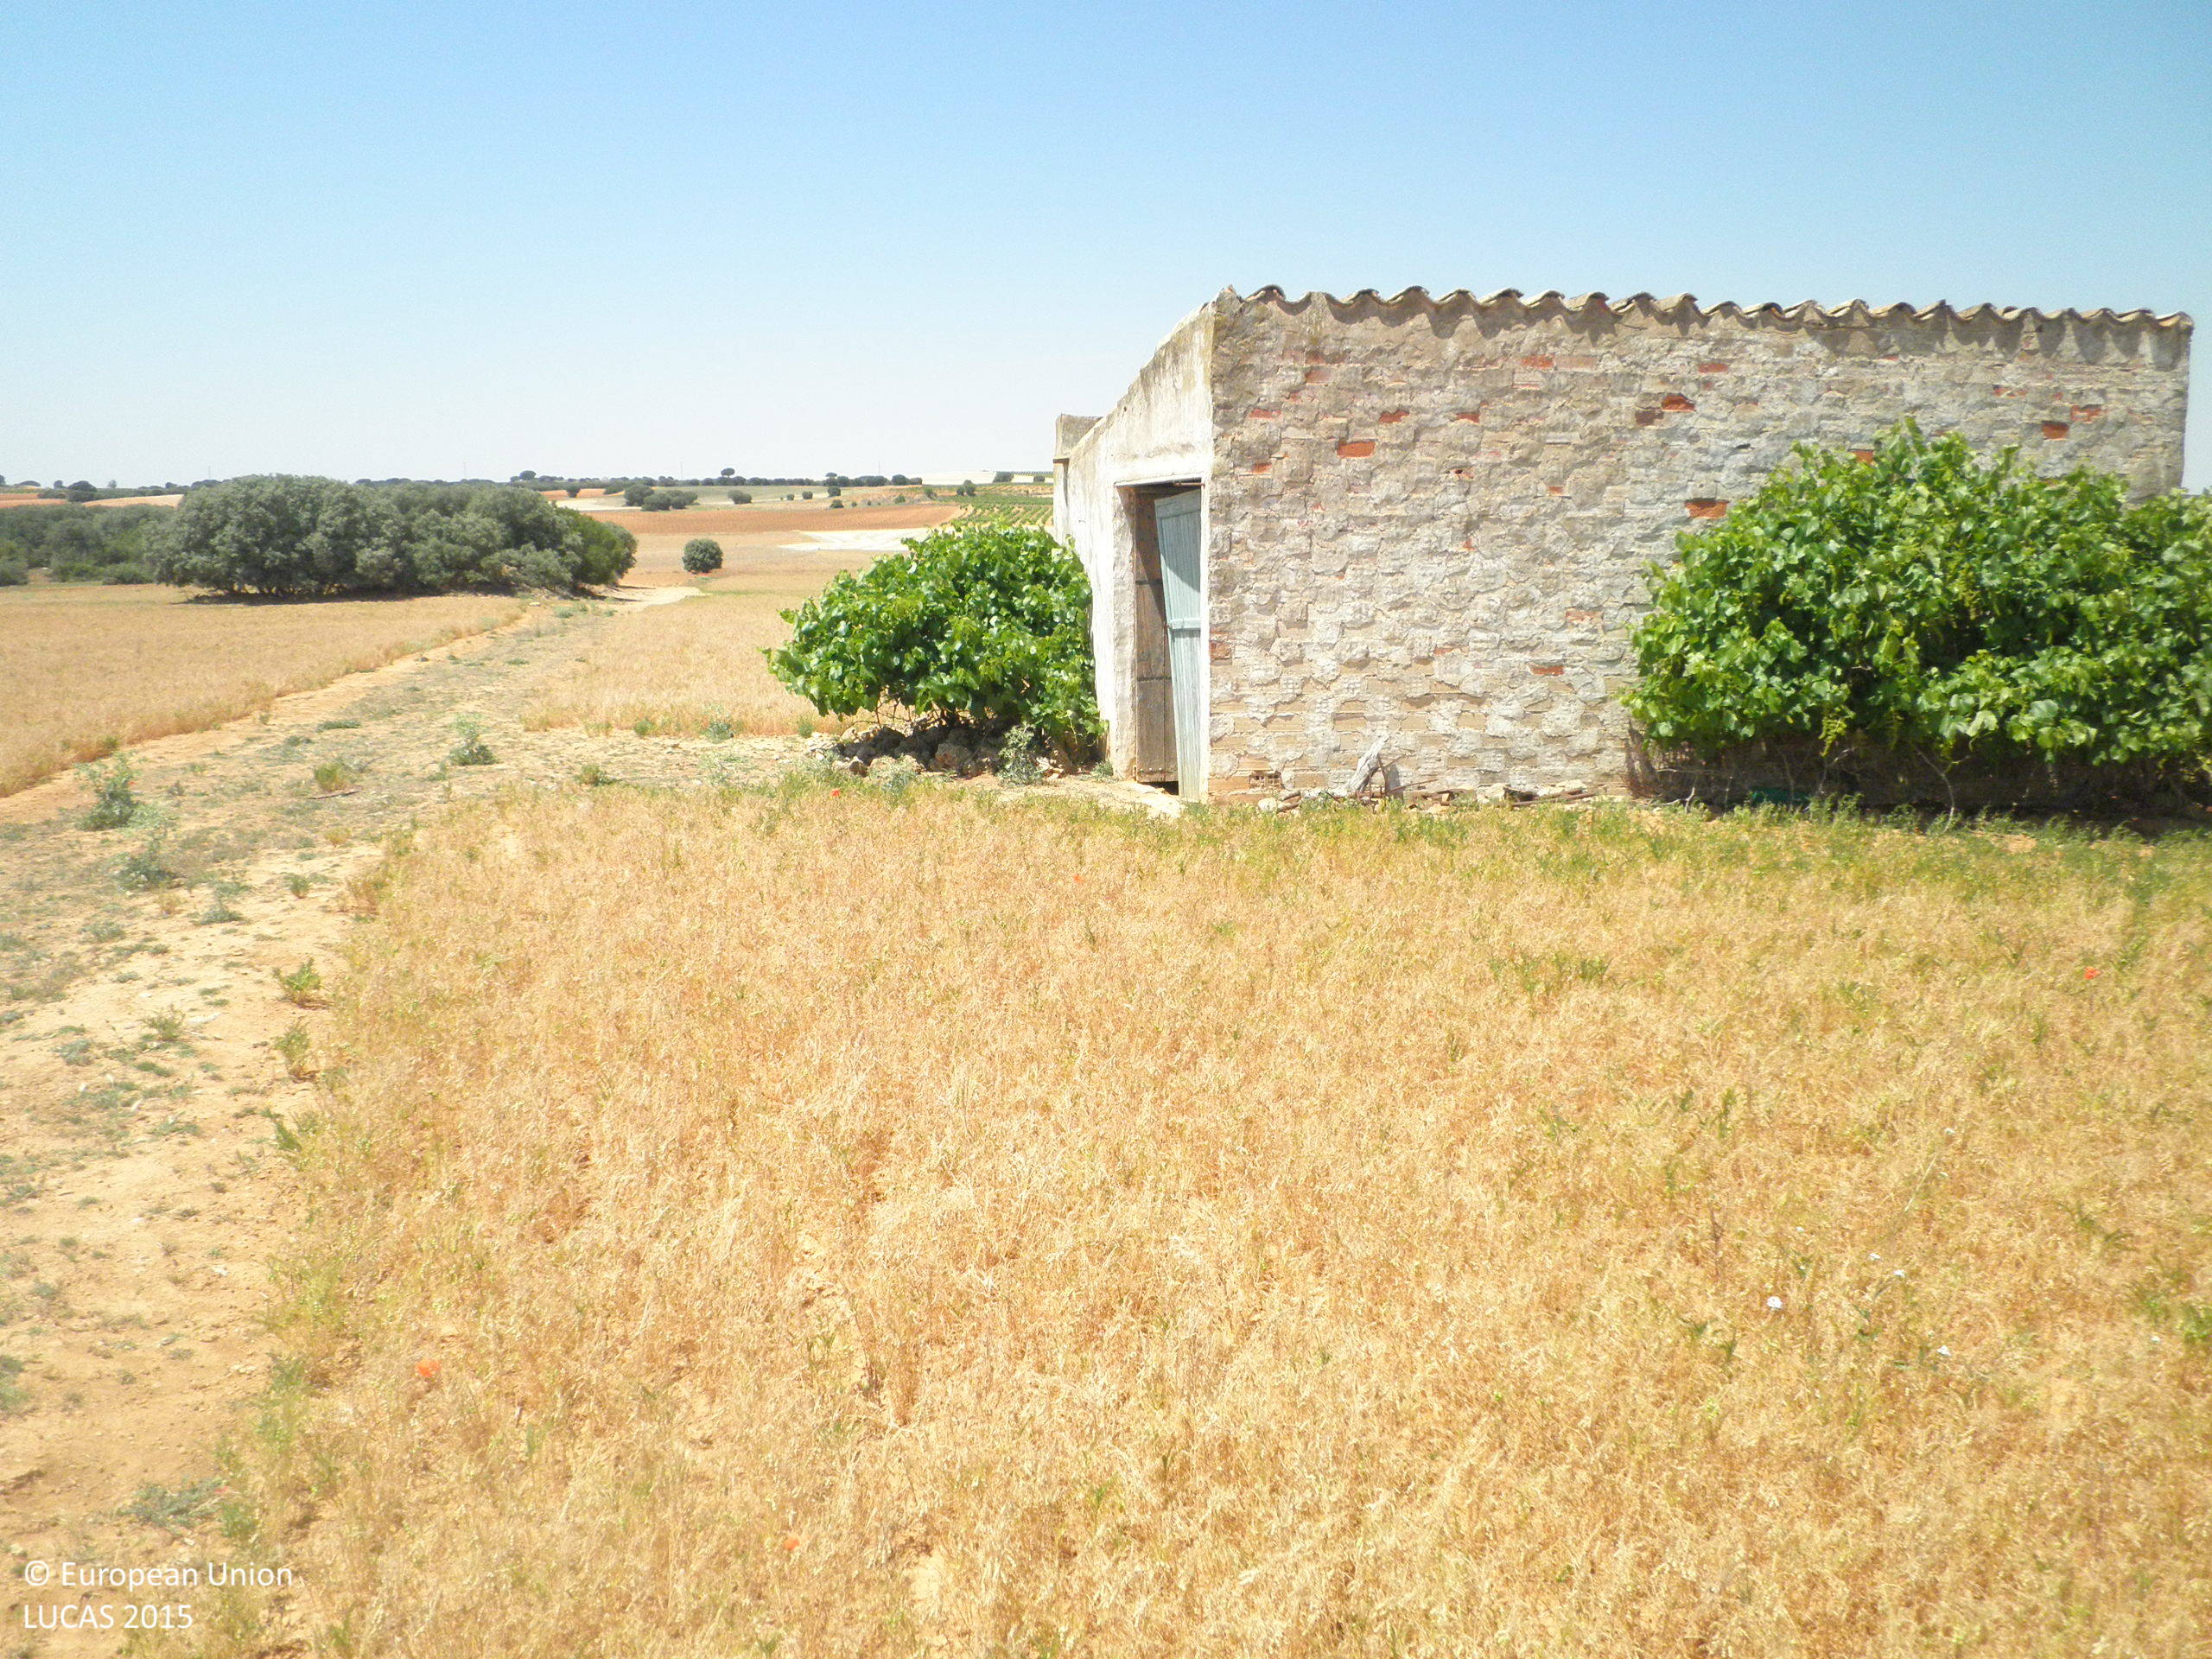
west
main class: Cropland
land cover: Dry pulses
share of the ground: > 75 %
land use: Agriculture (excluding fallow land and kitchen gardens)
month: June
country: ES
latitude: 39.4224
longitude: -1.8189
